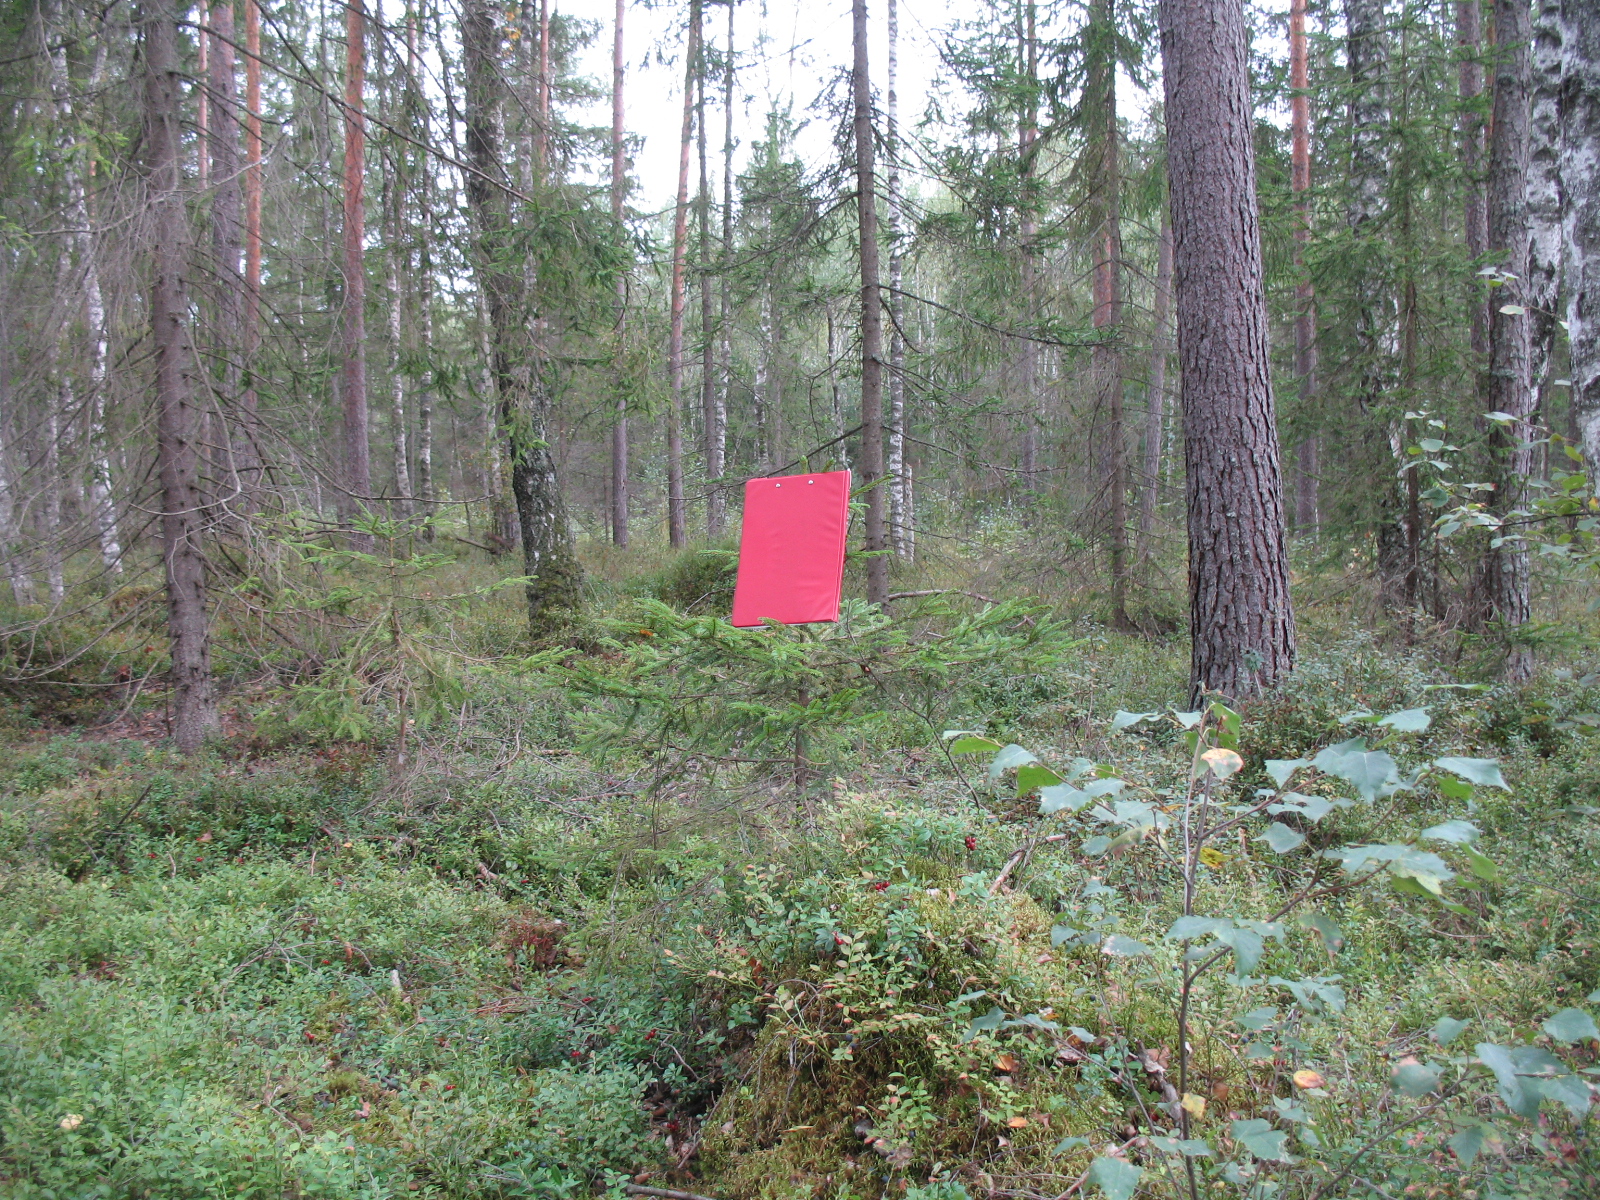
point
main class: Woodland
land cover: Other mixed woodland
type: hemiboreal forest and nemoral coniferous forest and mixed broadleaved-coniferous forest
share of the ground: 25 - 50 %
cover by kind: coniferous forest trees 25 %, herbaceous plants 25 %, lichens and mosses 25 %, broadleaved forest trees 20 %, shrubs 5 %
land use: Forestry
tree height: > 5 m
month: September
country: LV
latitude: 56.1531
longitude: 25.9589
